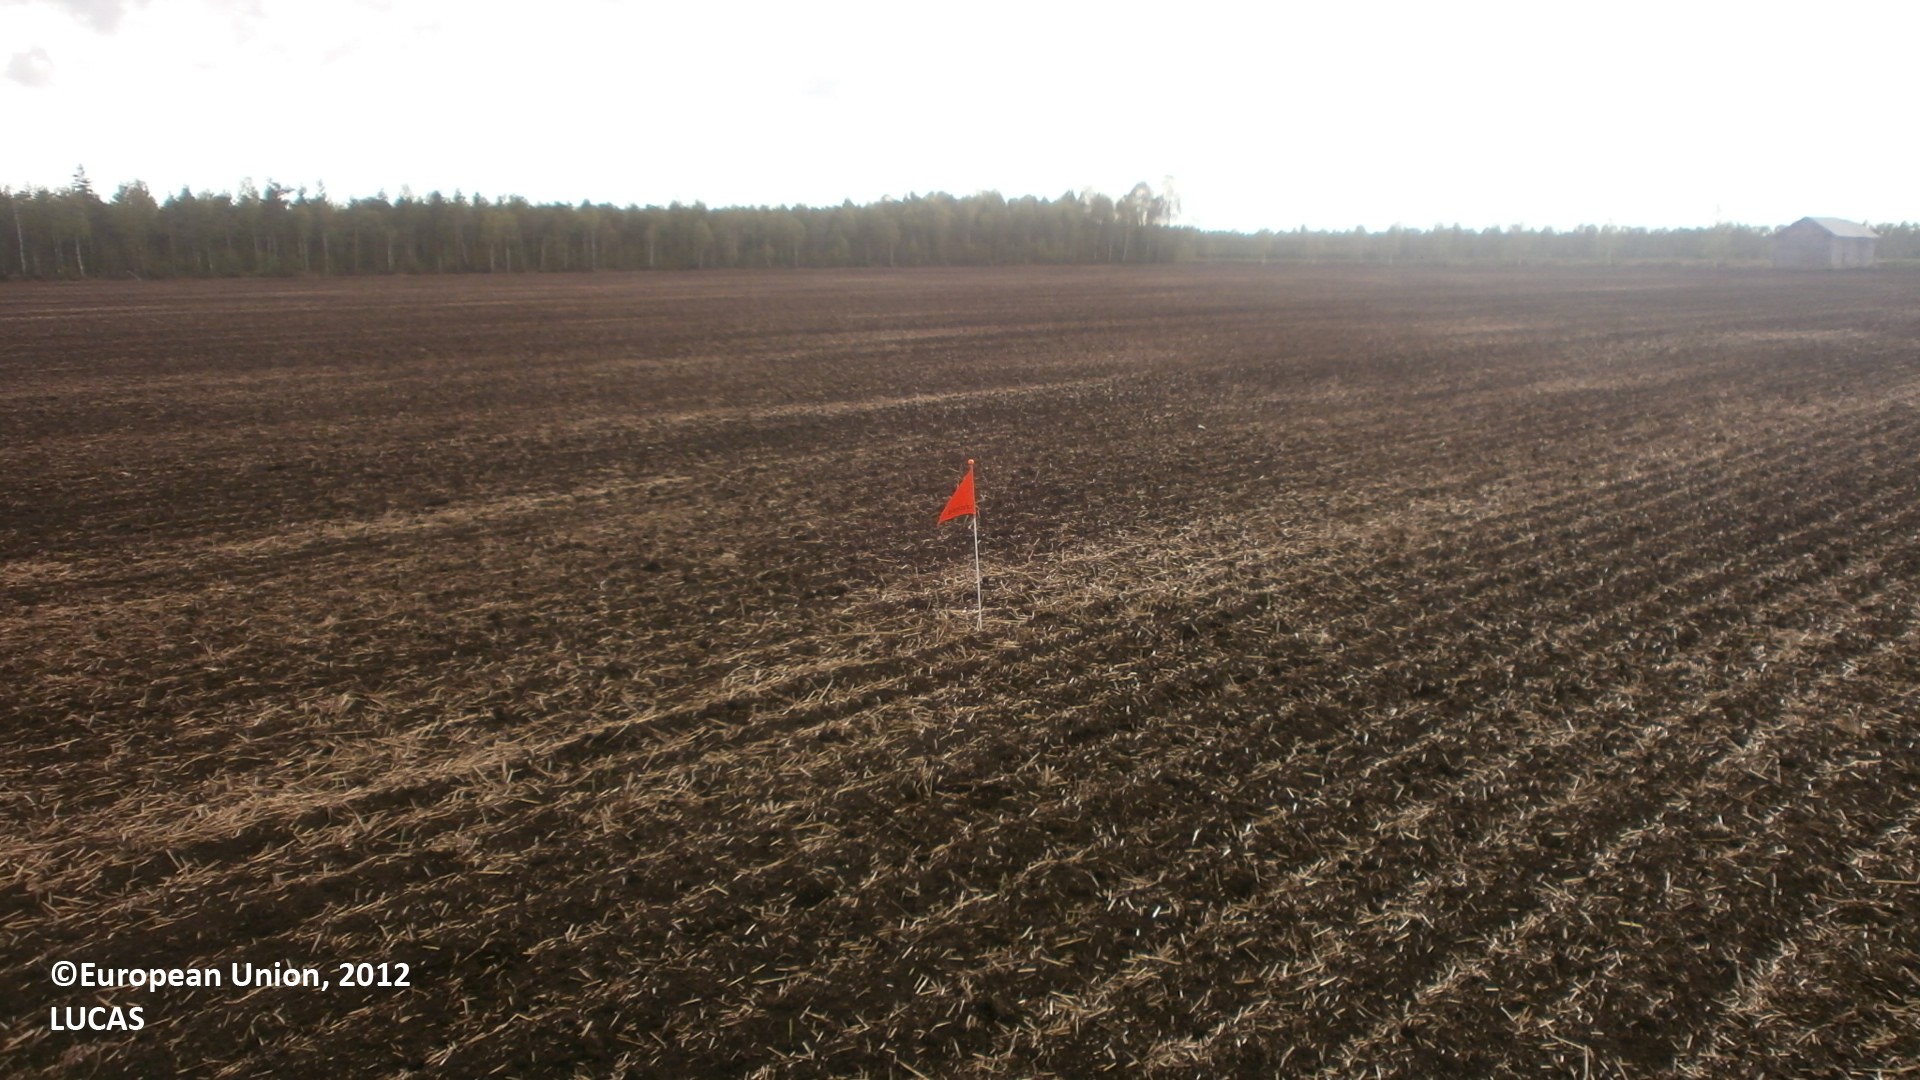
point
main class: Cropland
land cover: Barley
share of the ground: < 10 %
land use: Agriculture (excluding fallow land and kitchen gardens)
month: June
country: FI
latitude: 64.6808
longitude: 25.1481
